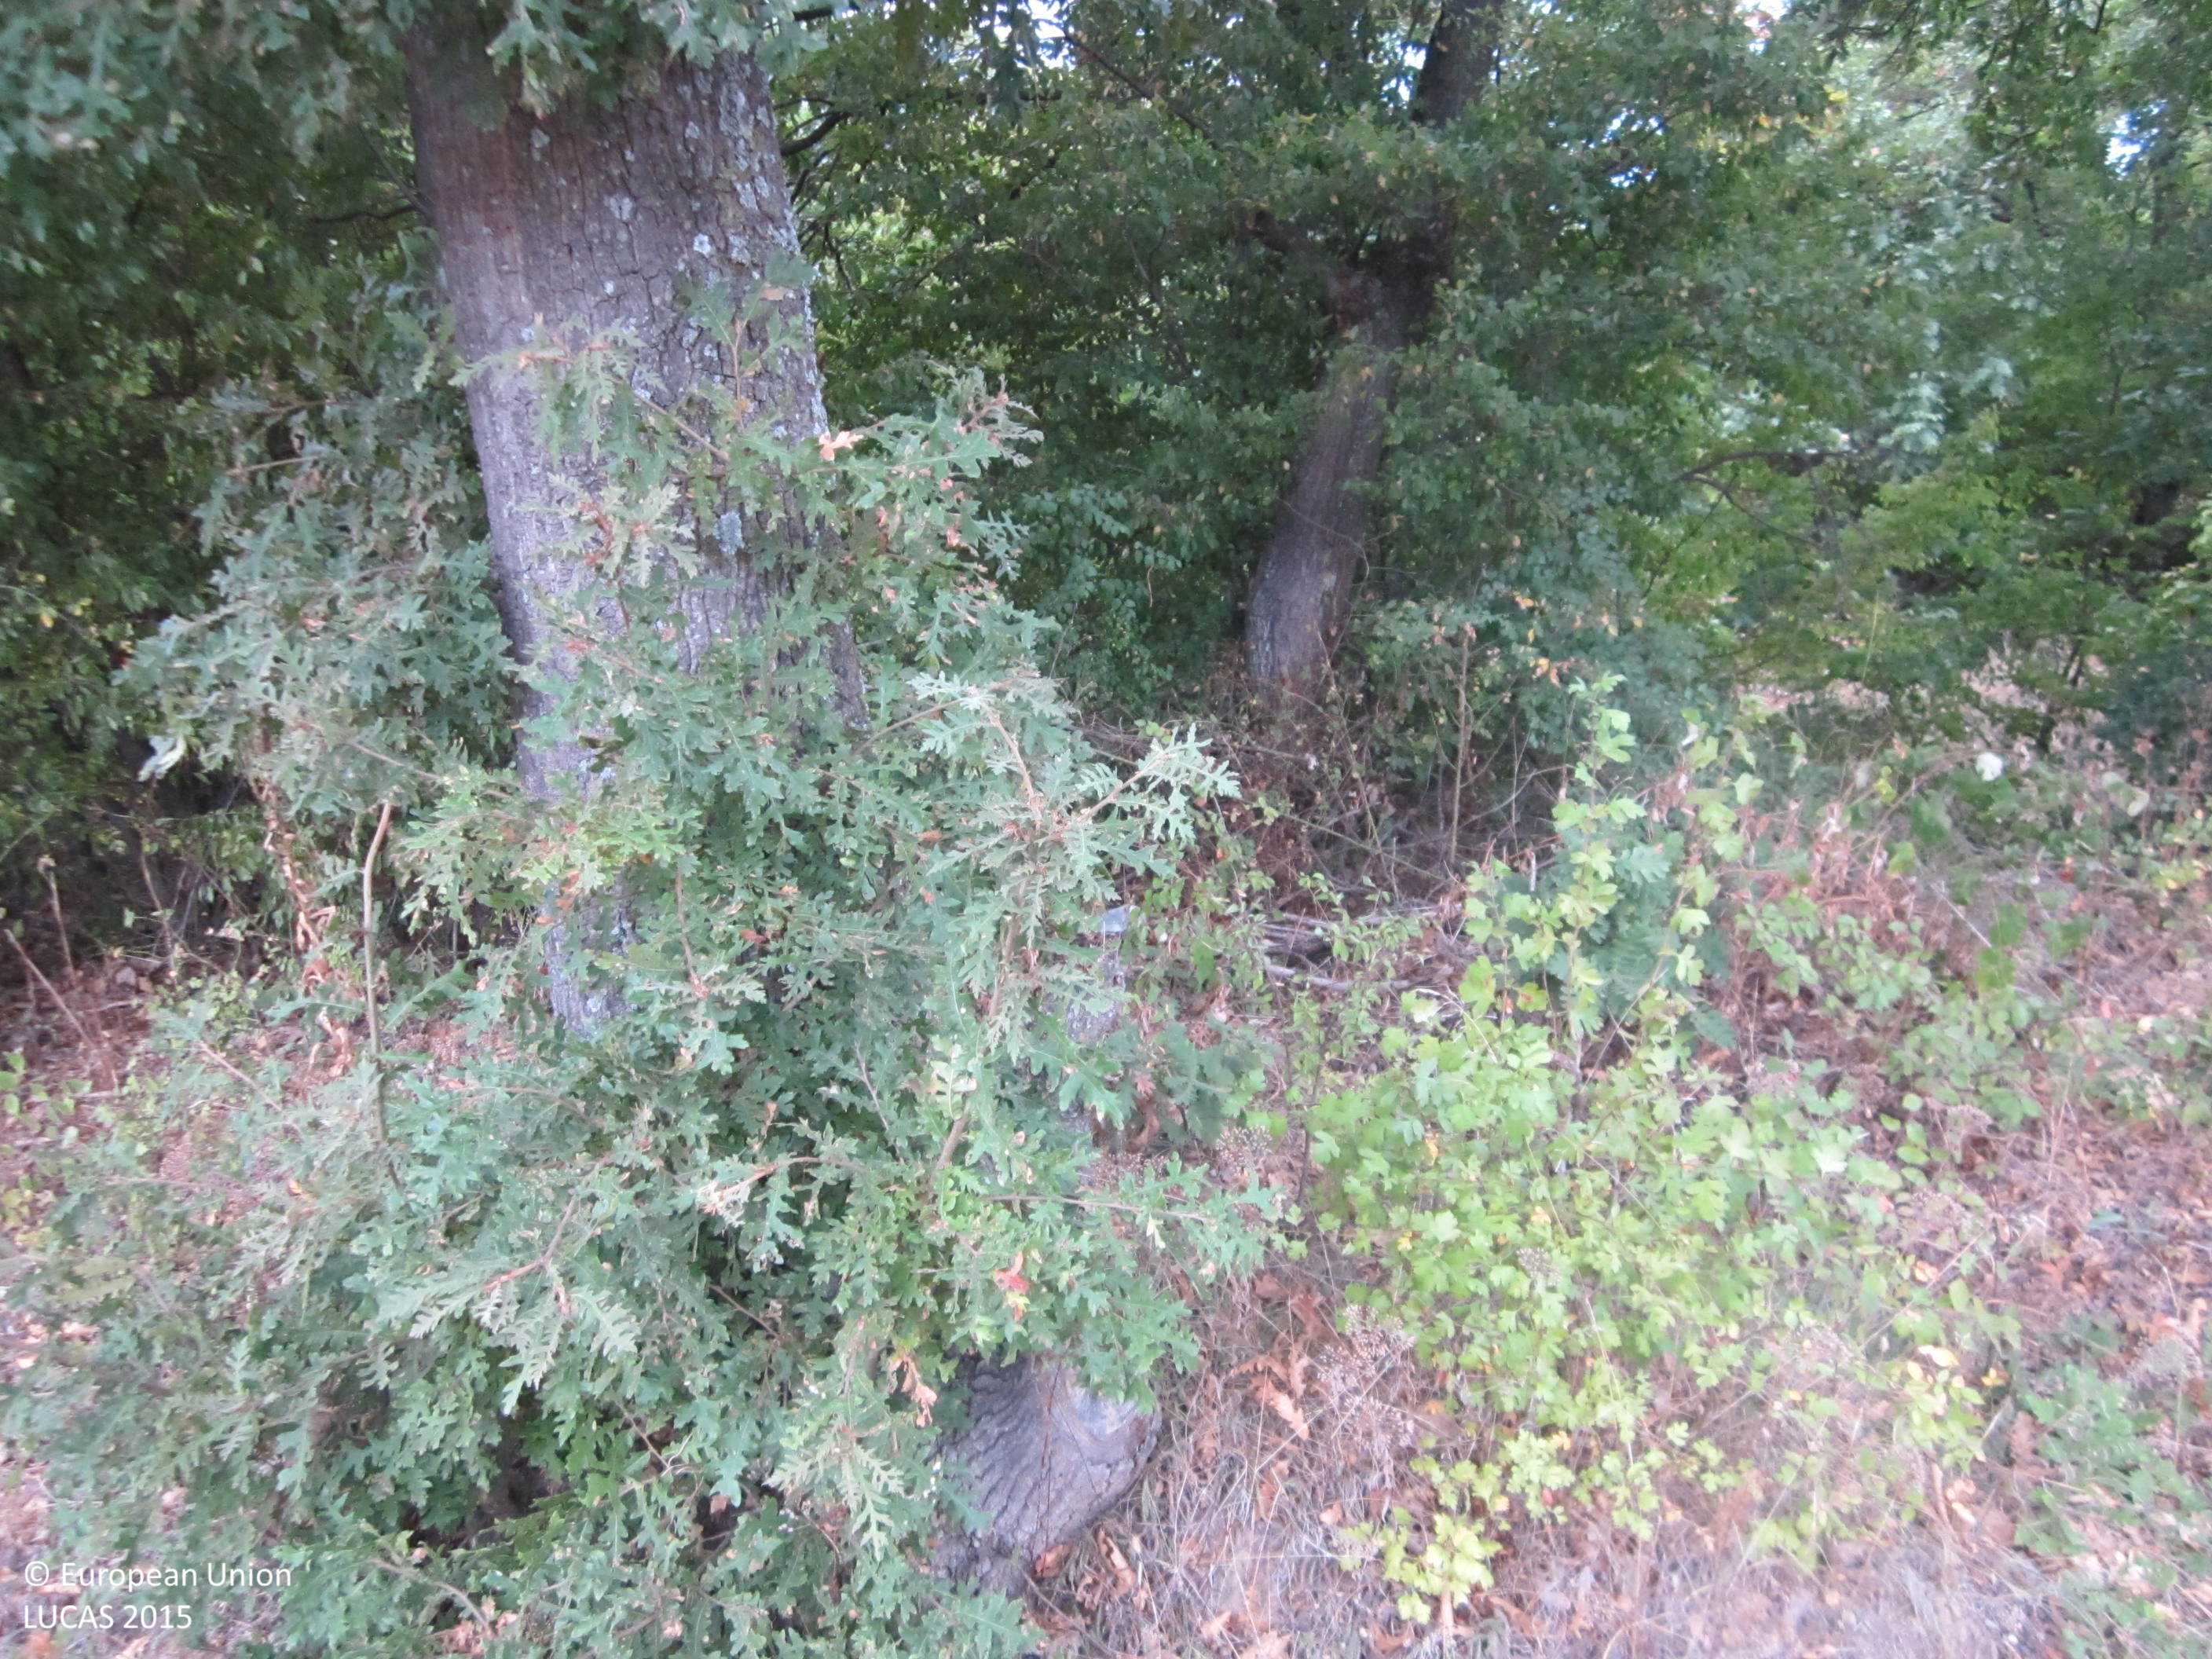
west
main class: Cropland
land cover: Nuts trees
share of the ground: 10 - 25 %
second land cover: Grassland without tree/shrub cover
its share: 25 - 50 %
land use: Agriculture (excluding fallow land and kitchen gardens)
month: September
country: BG
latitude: 42.8114
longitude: 27.3995
